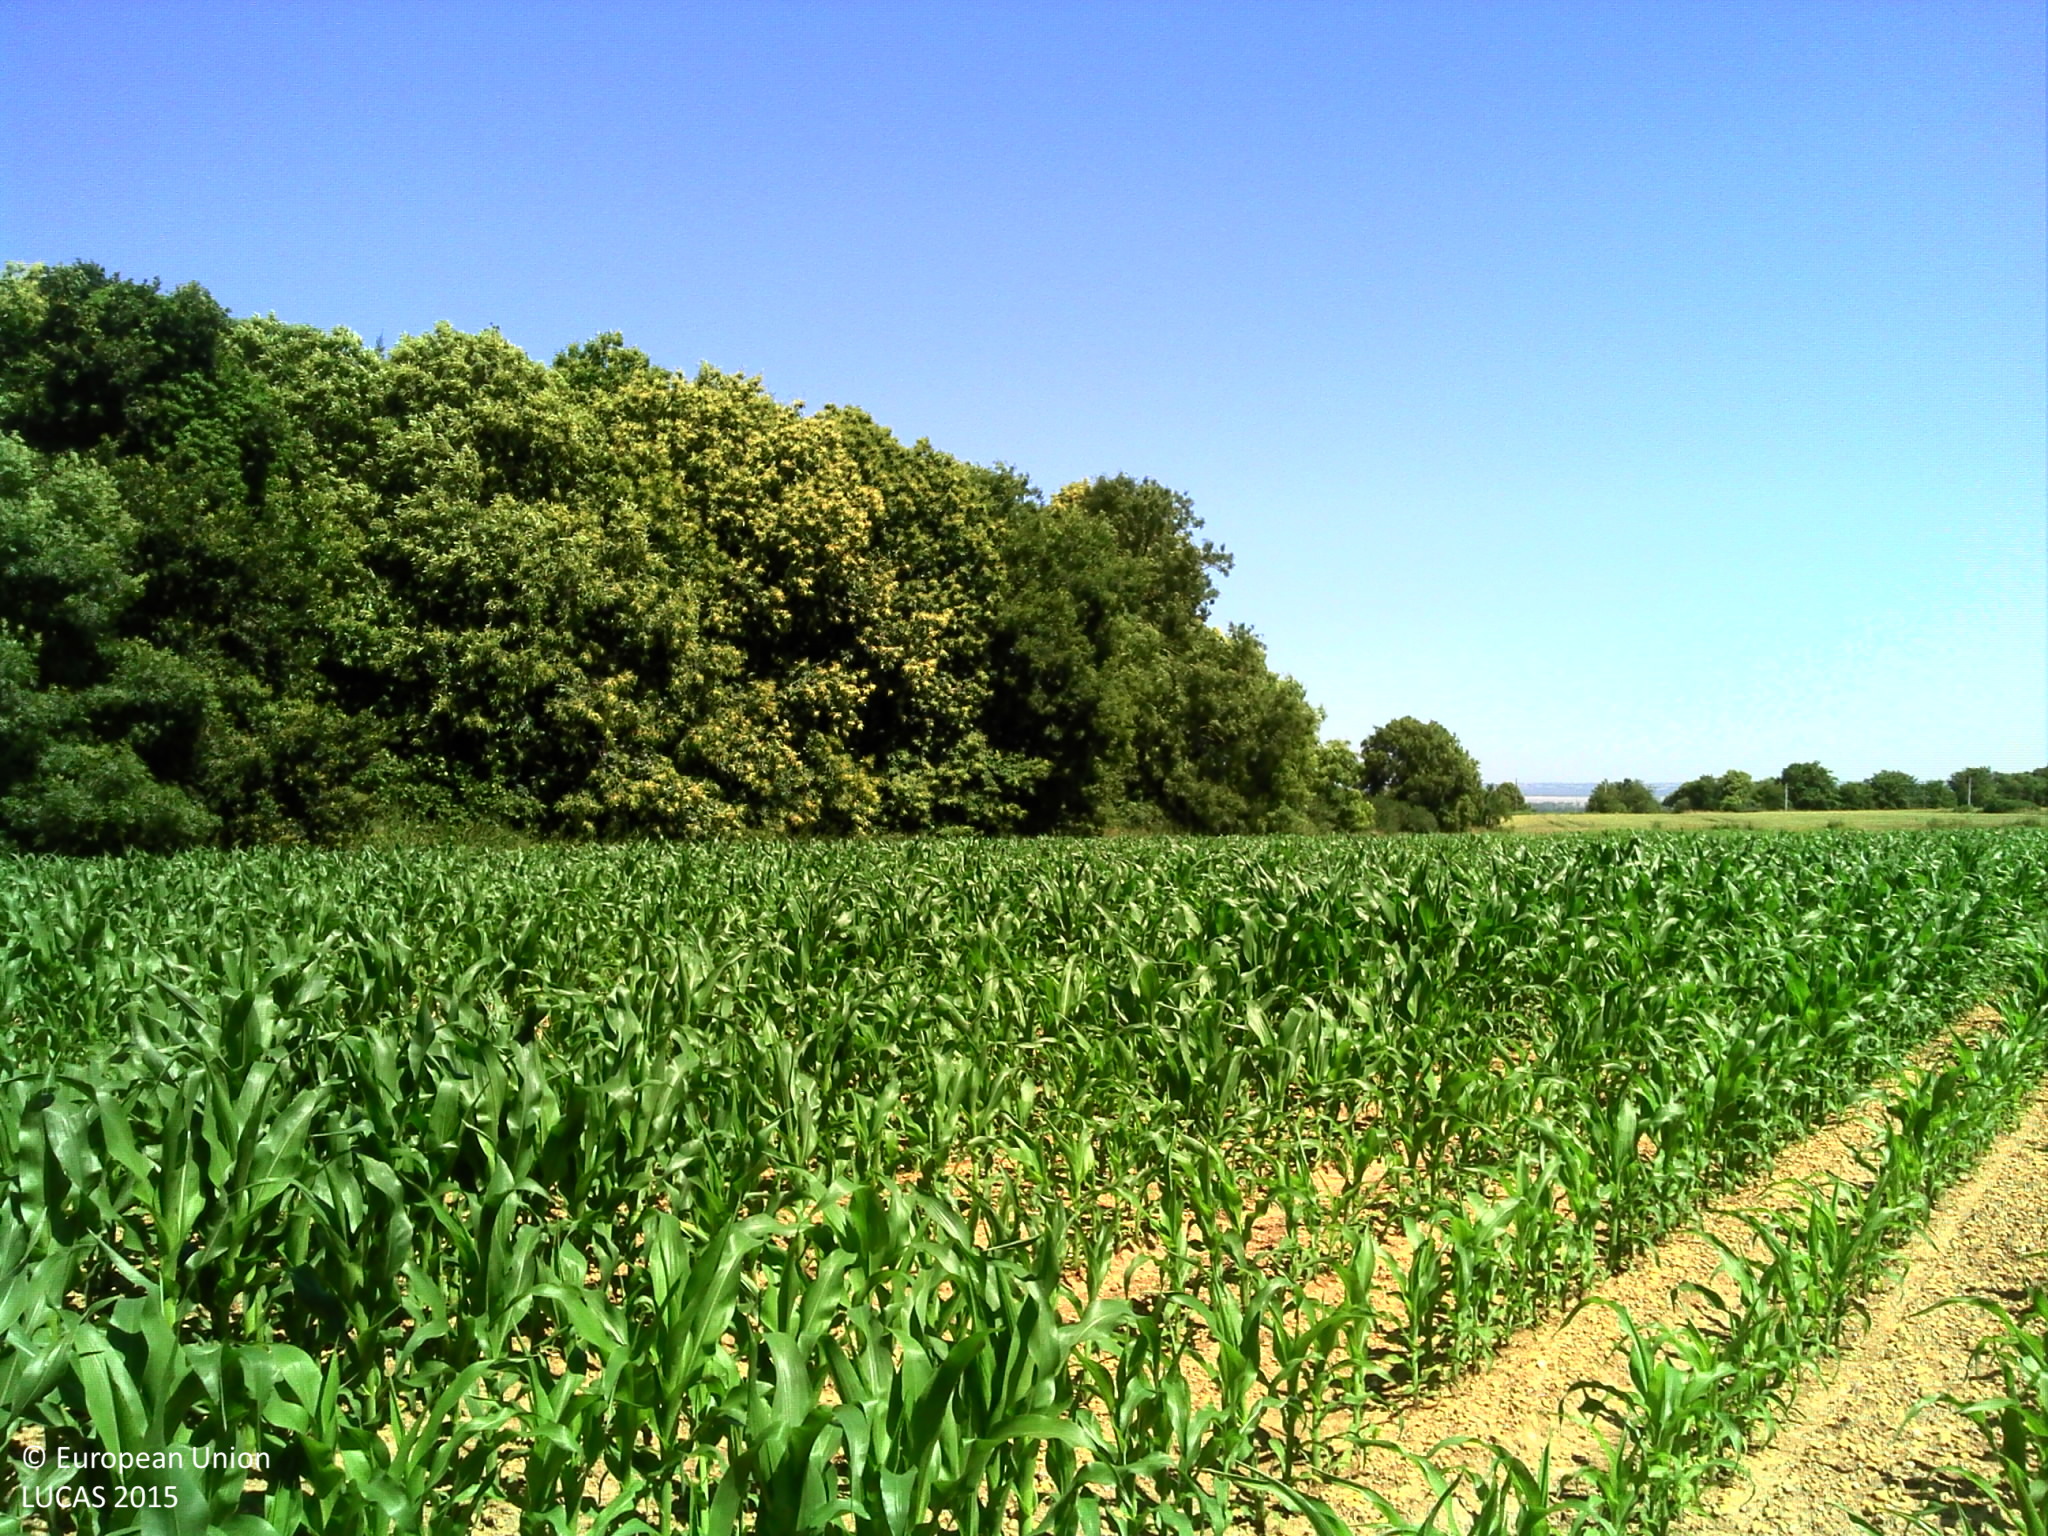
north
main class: Cropland
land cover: Maize
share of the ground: 25 - 50 %
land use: Agriculture (excluding fallow land and kitchen gardens)
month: June
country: FR
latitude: 48.5740
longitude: -1.5824
